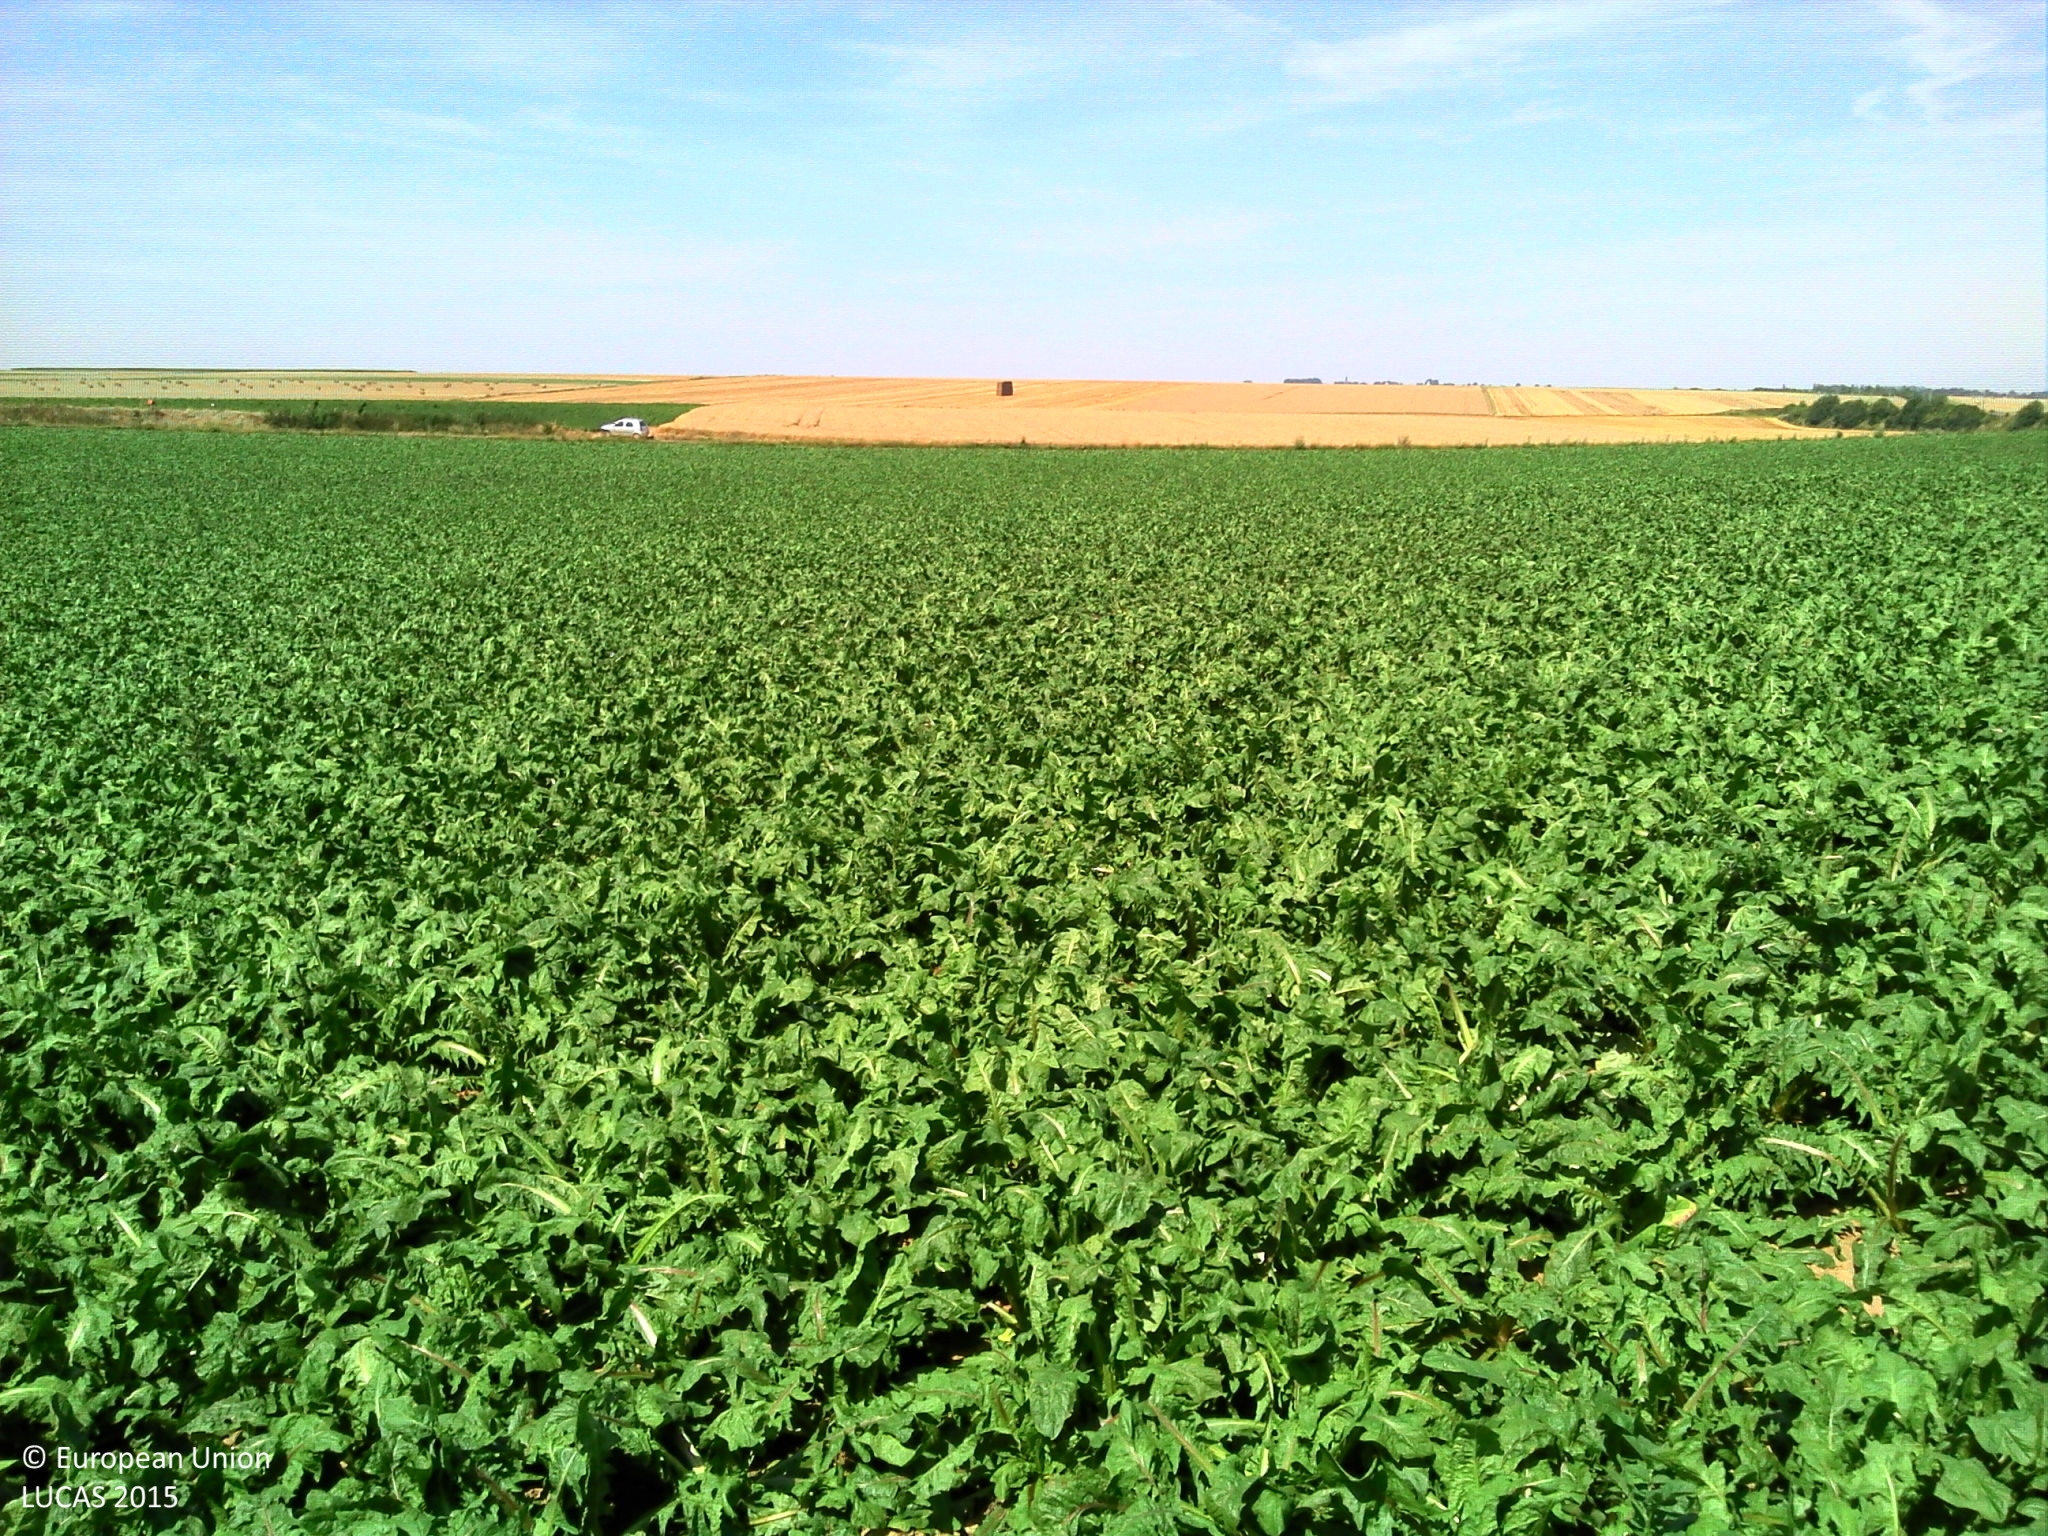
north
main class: Cropland
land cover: Other root crops
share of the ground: > 75 %
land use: Agriculture (excluding fallow land and kitchen gardens)
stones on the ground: < 10 %
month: August
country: FR
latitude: 50.2333
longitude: 3.1917
